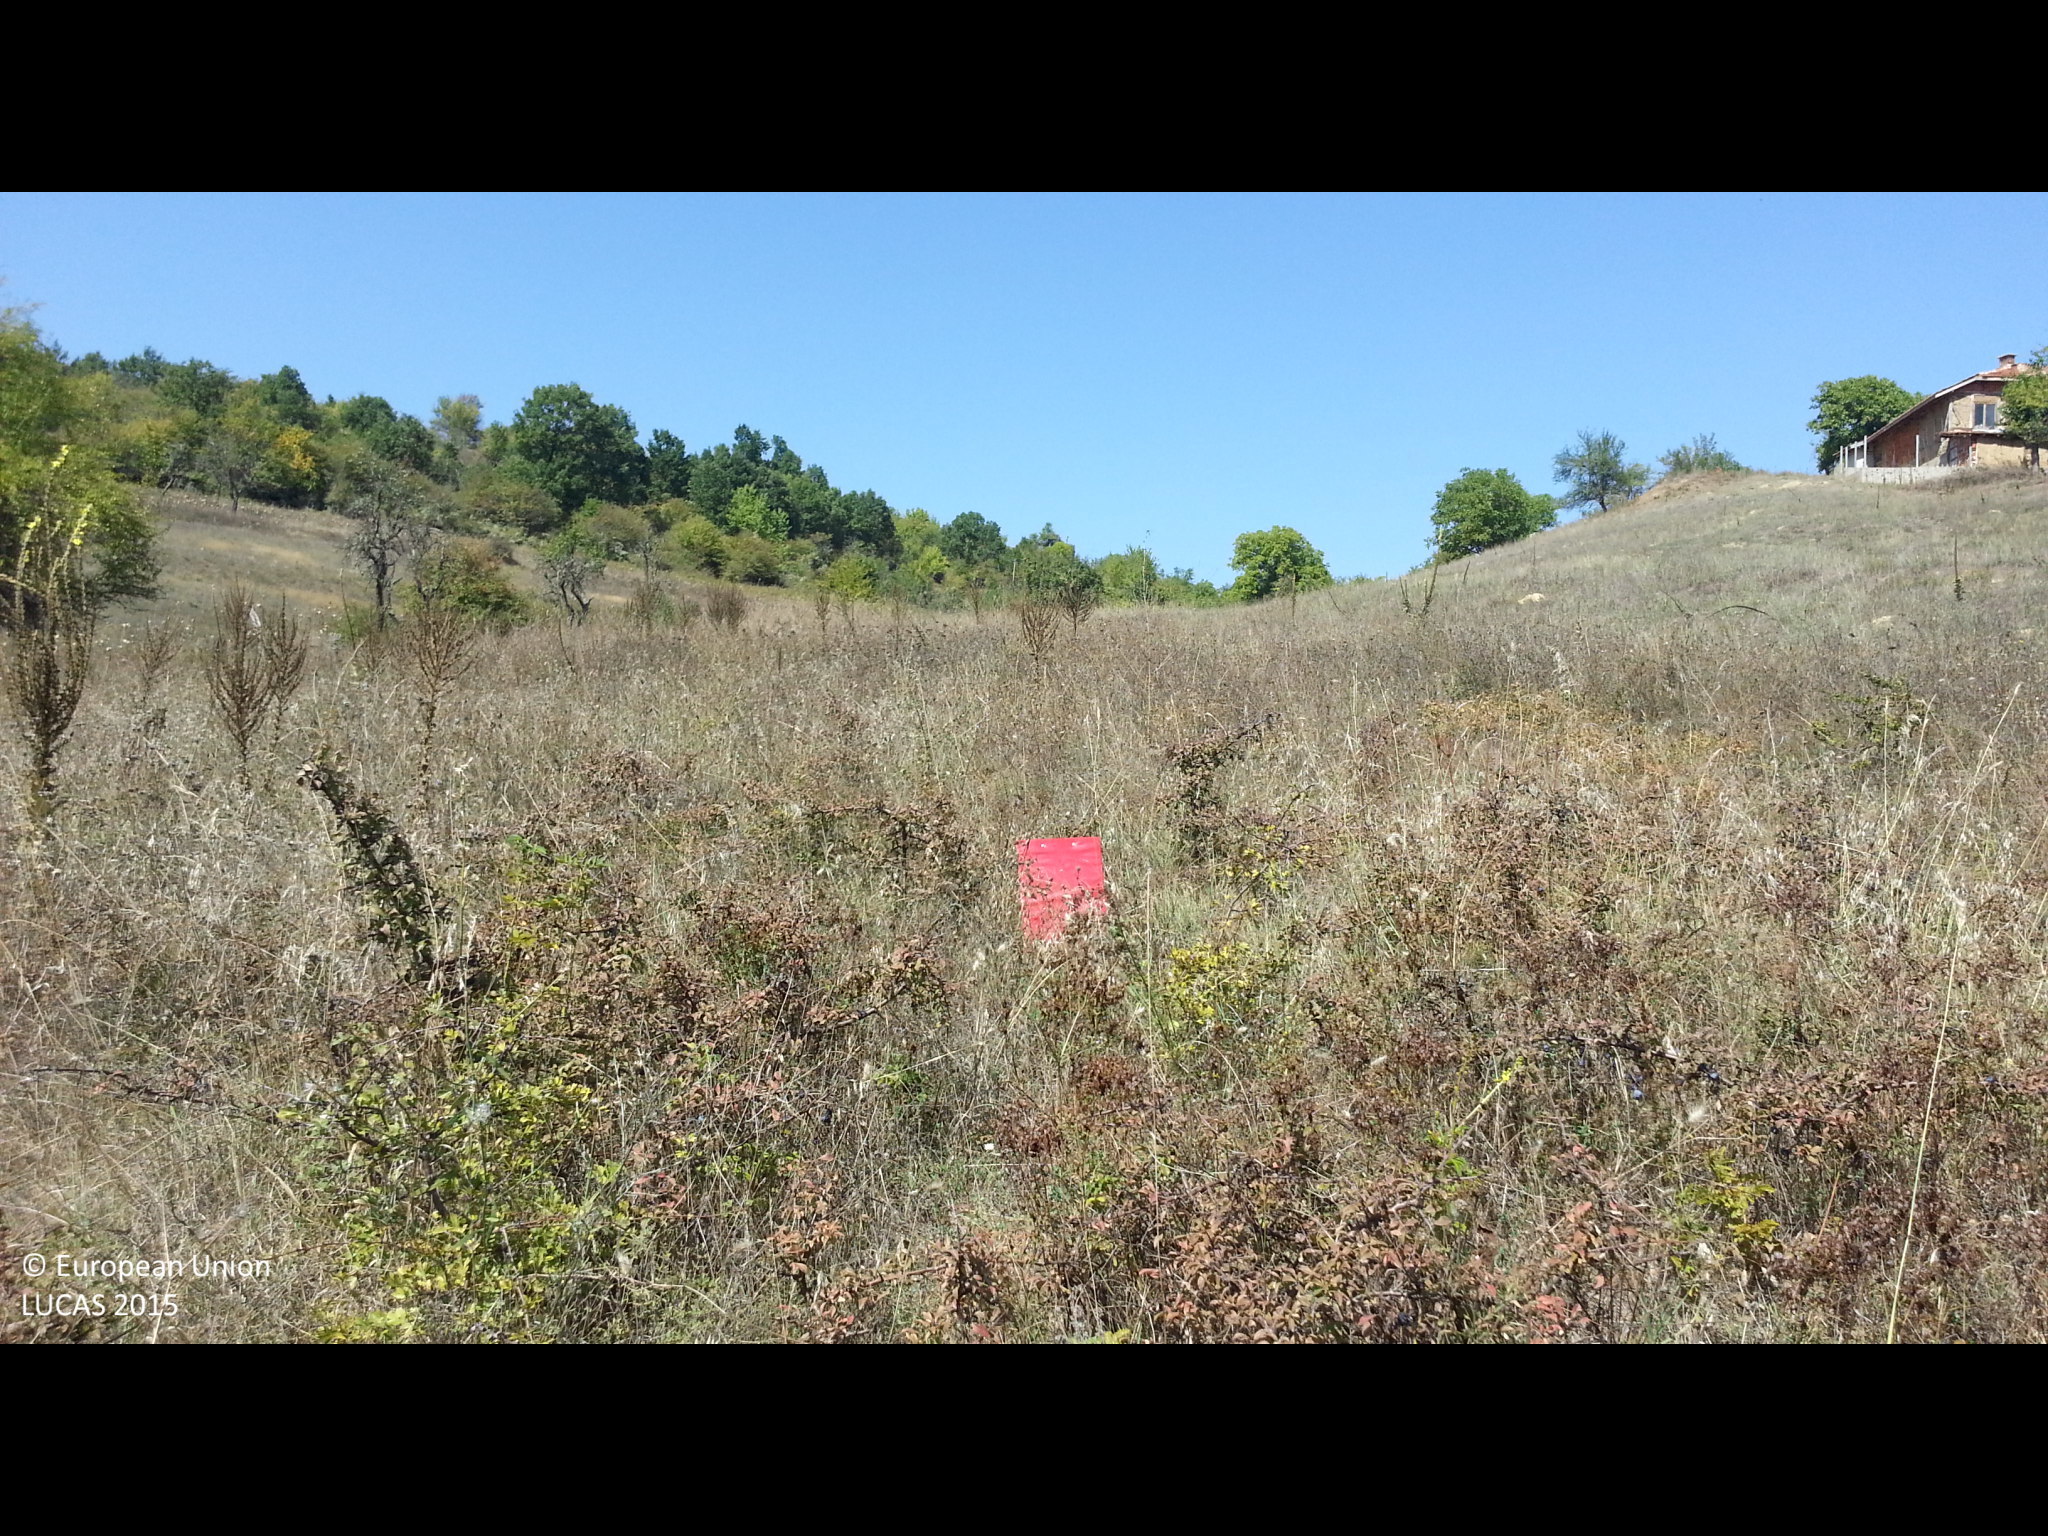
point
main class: Grassland
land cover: Grassland without tree/shrub cover
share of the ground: > 75 %
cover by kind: herbaceous plants 100 %
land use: Agriculture (excluding fallow land and kitchen gardens)
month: September
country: BG
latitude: 42.1618
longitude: 22.8400
